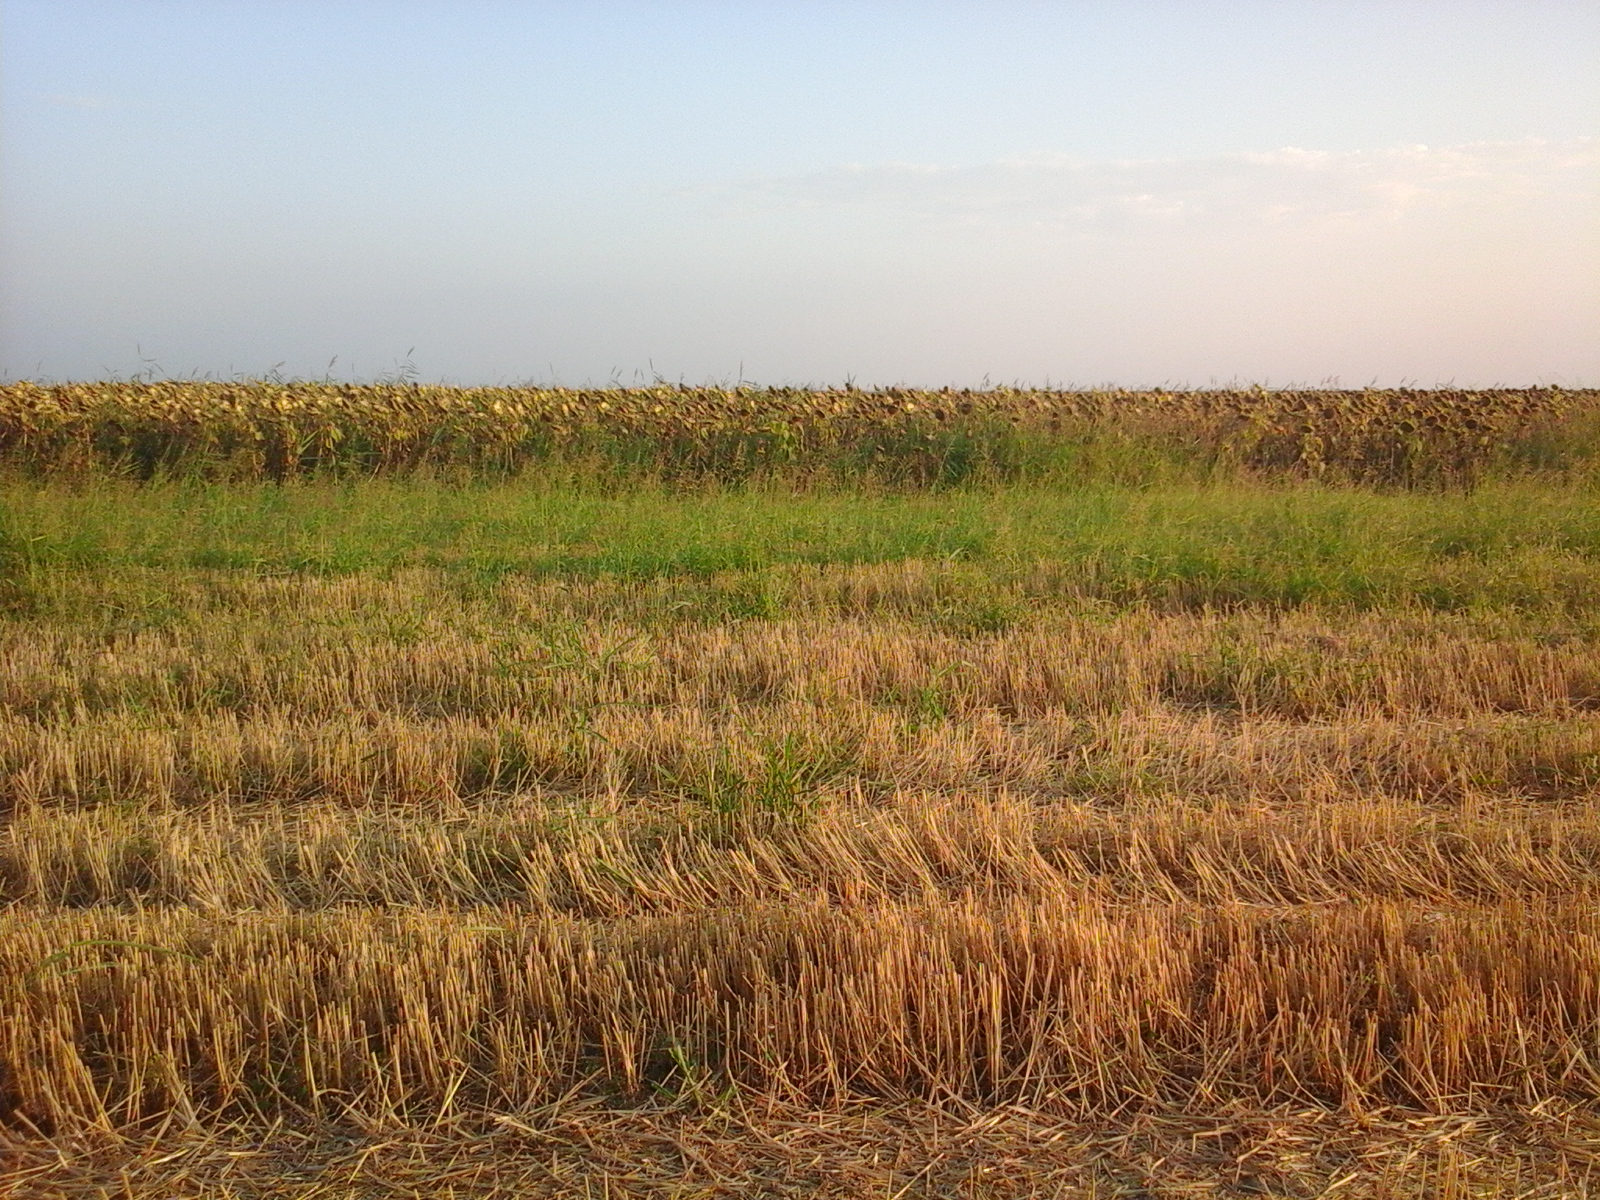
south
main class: Cropland
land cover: Common wheat
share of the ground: 50 - 75 %
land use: Agriculture (excluding fallow land and kitchen gardens)
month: August
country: RO
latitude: 44.0010
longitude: 23.5815
